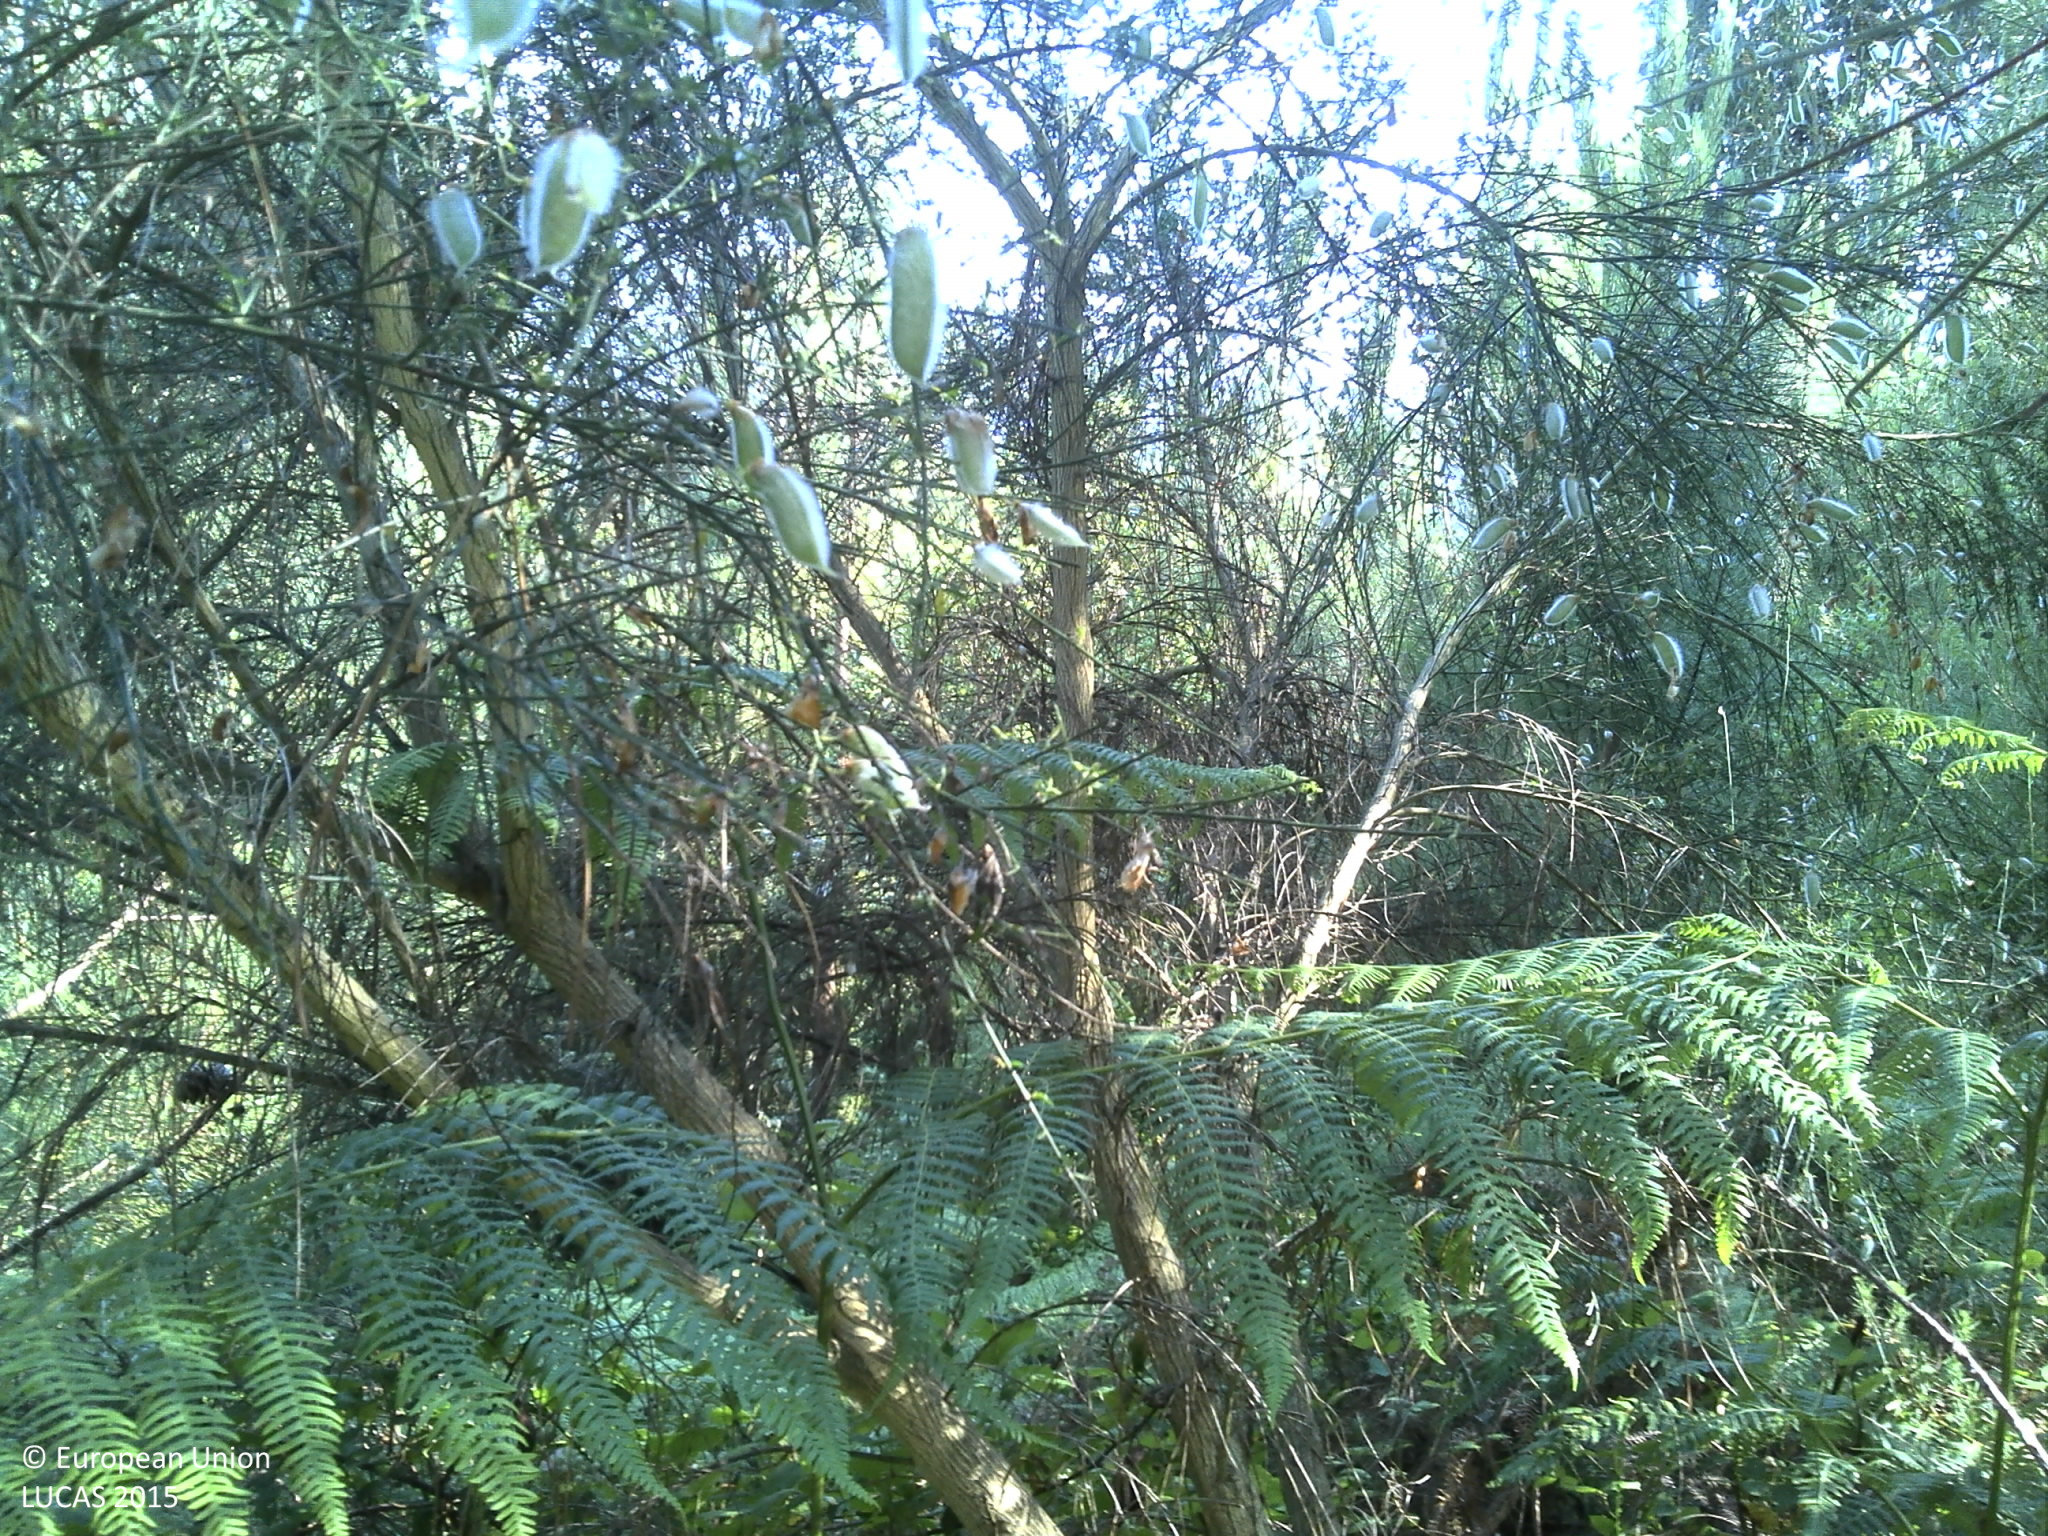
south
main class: Woodland
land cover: Pine dominated coniferous woodland
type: coniferous forest of the mediterranean region
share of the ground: 50 - 75 %
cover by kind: coniferous forest trees 75 %, shrubs 10 %, unconsolidated bare surface 10 %, herbaceous plants 5 %
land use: Forestry
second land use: Agriculture (excluding fallow land and kitchen gardens)
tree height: > 5 m
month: June
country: PT
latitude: 42.0559
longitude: -8.3202
